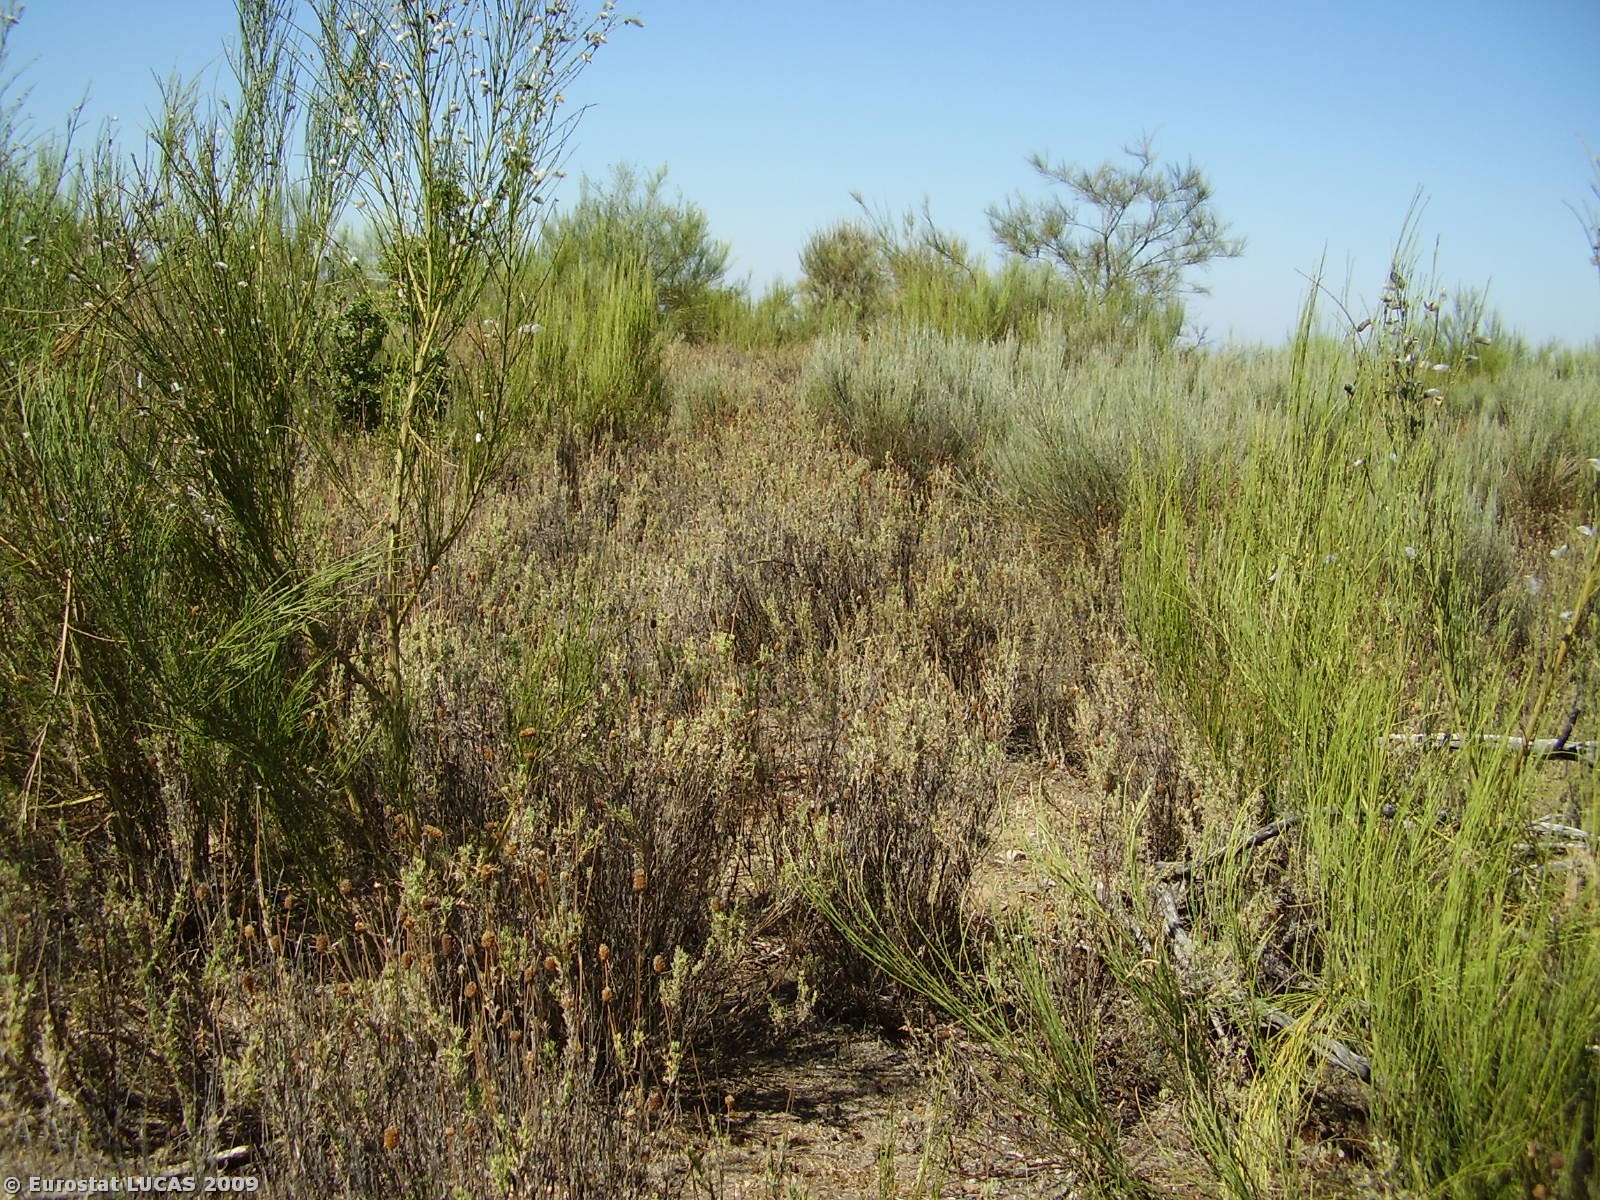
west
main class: Shrubland
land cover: Shrubland without tree cover
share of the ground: > 75 %
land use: Fallow land
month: August
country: PT
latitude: 41.2296
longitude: -6.7467
